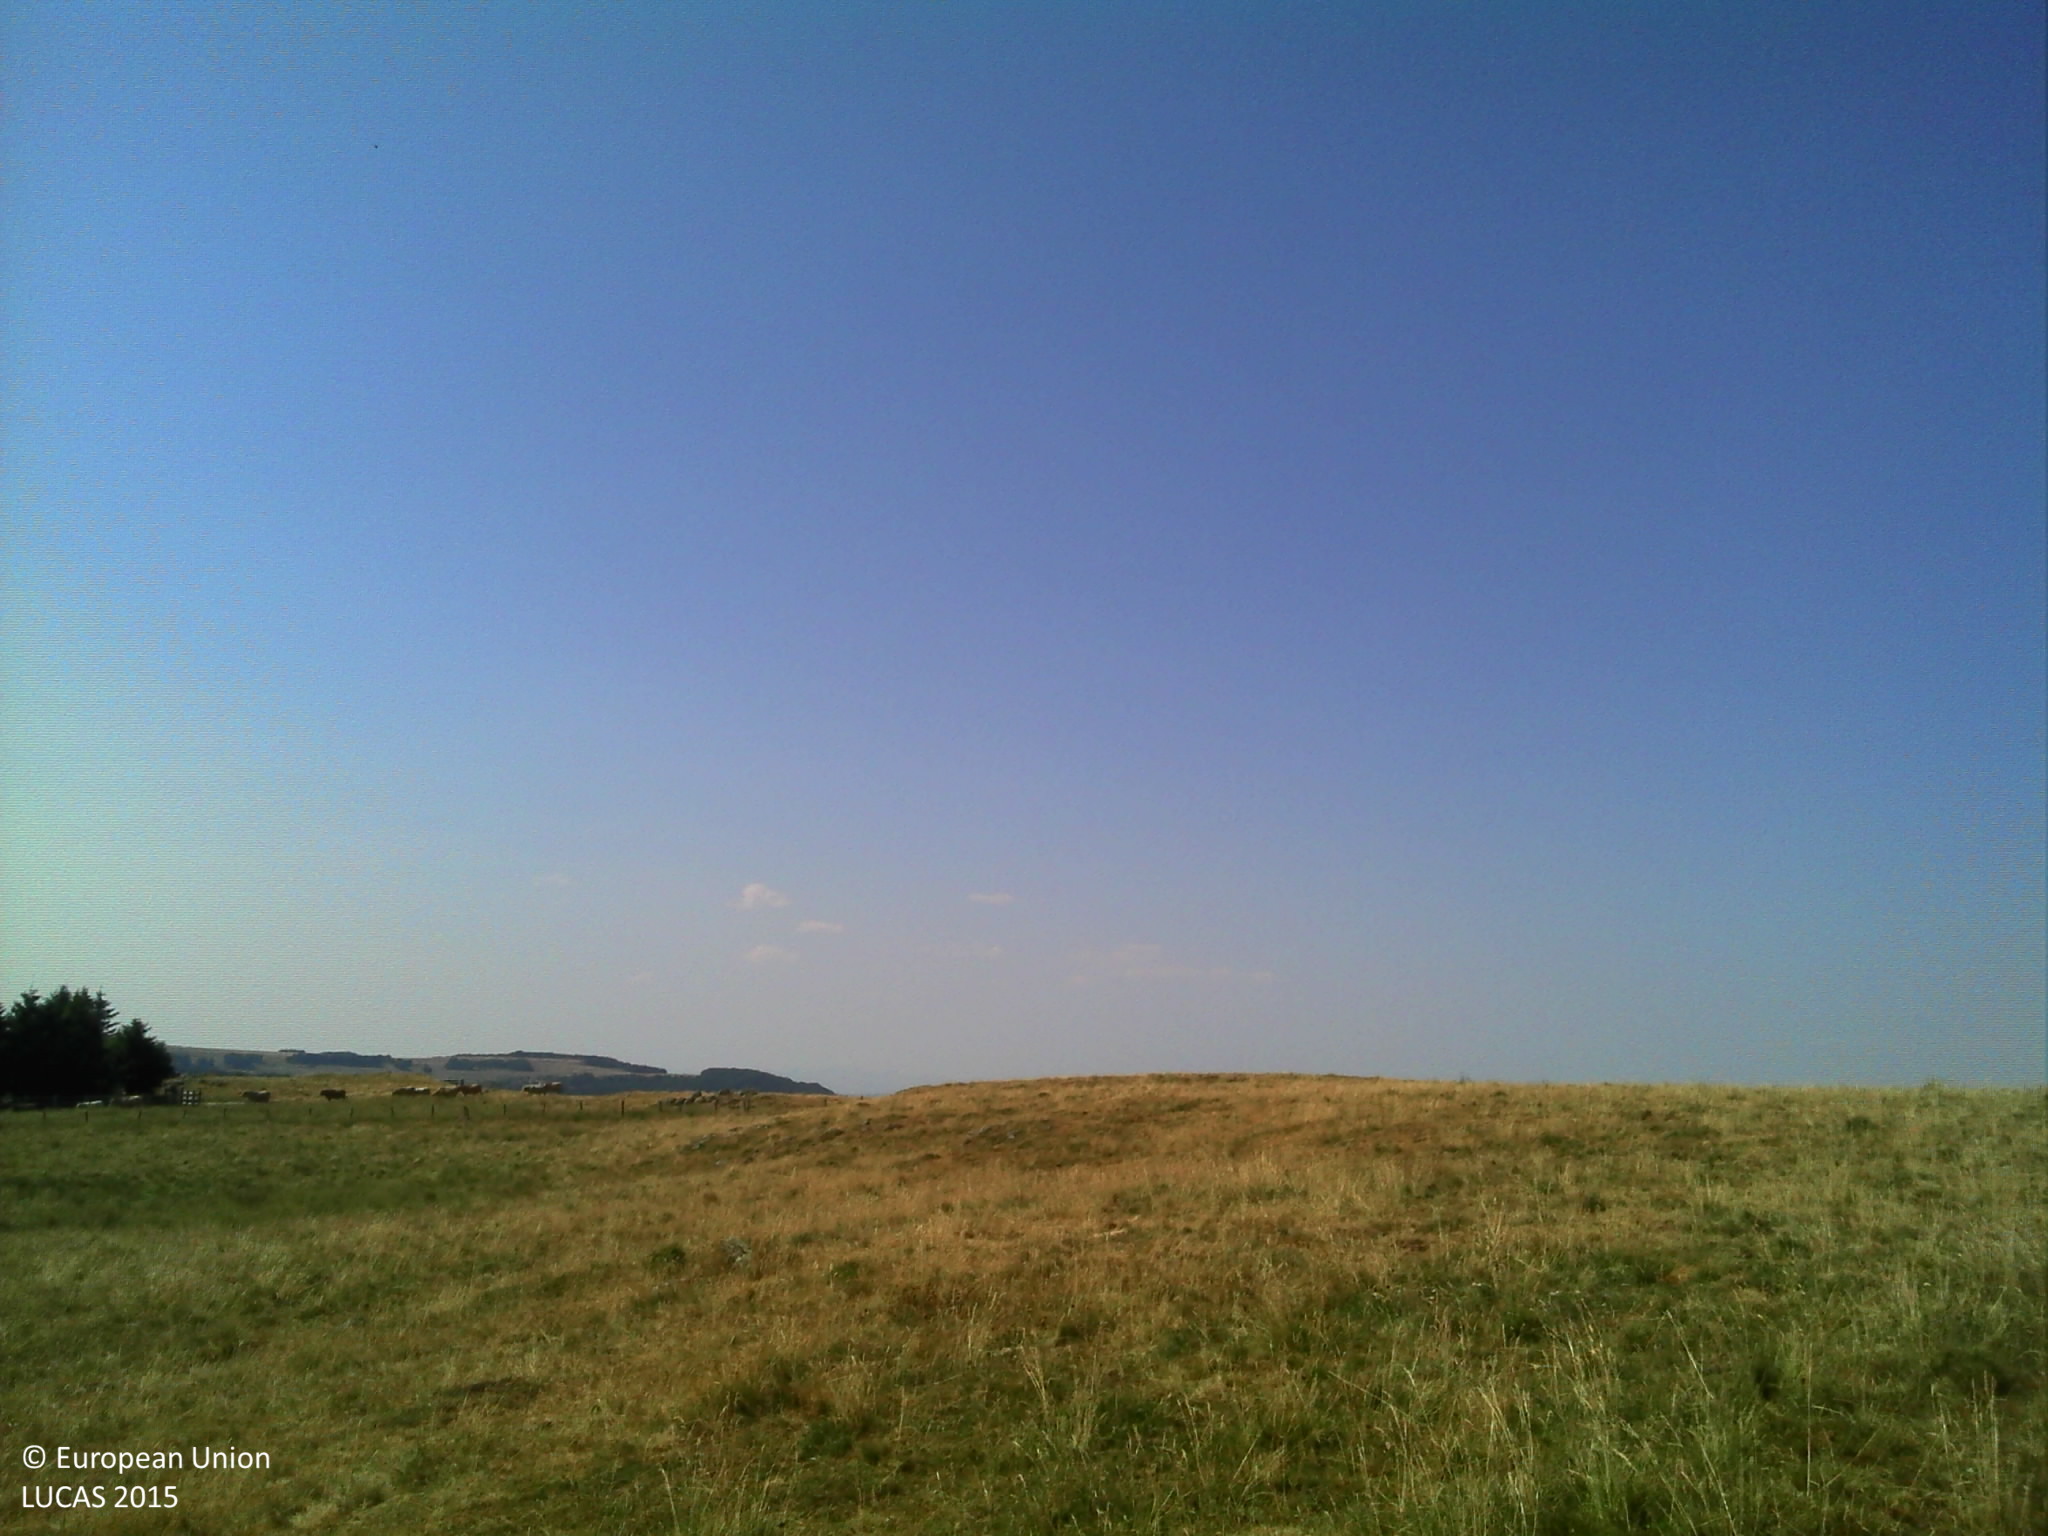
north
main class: Grassland
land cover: Grassland without tree/shrub cover
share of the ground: > 75 %
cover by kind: herbaceous plants 95 %, shrubs 5 %
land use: Agriculture (excluding fallow land and kitchen gardens)
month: July
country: FR
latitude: 44.6084
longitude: 3.0863
